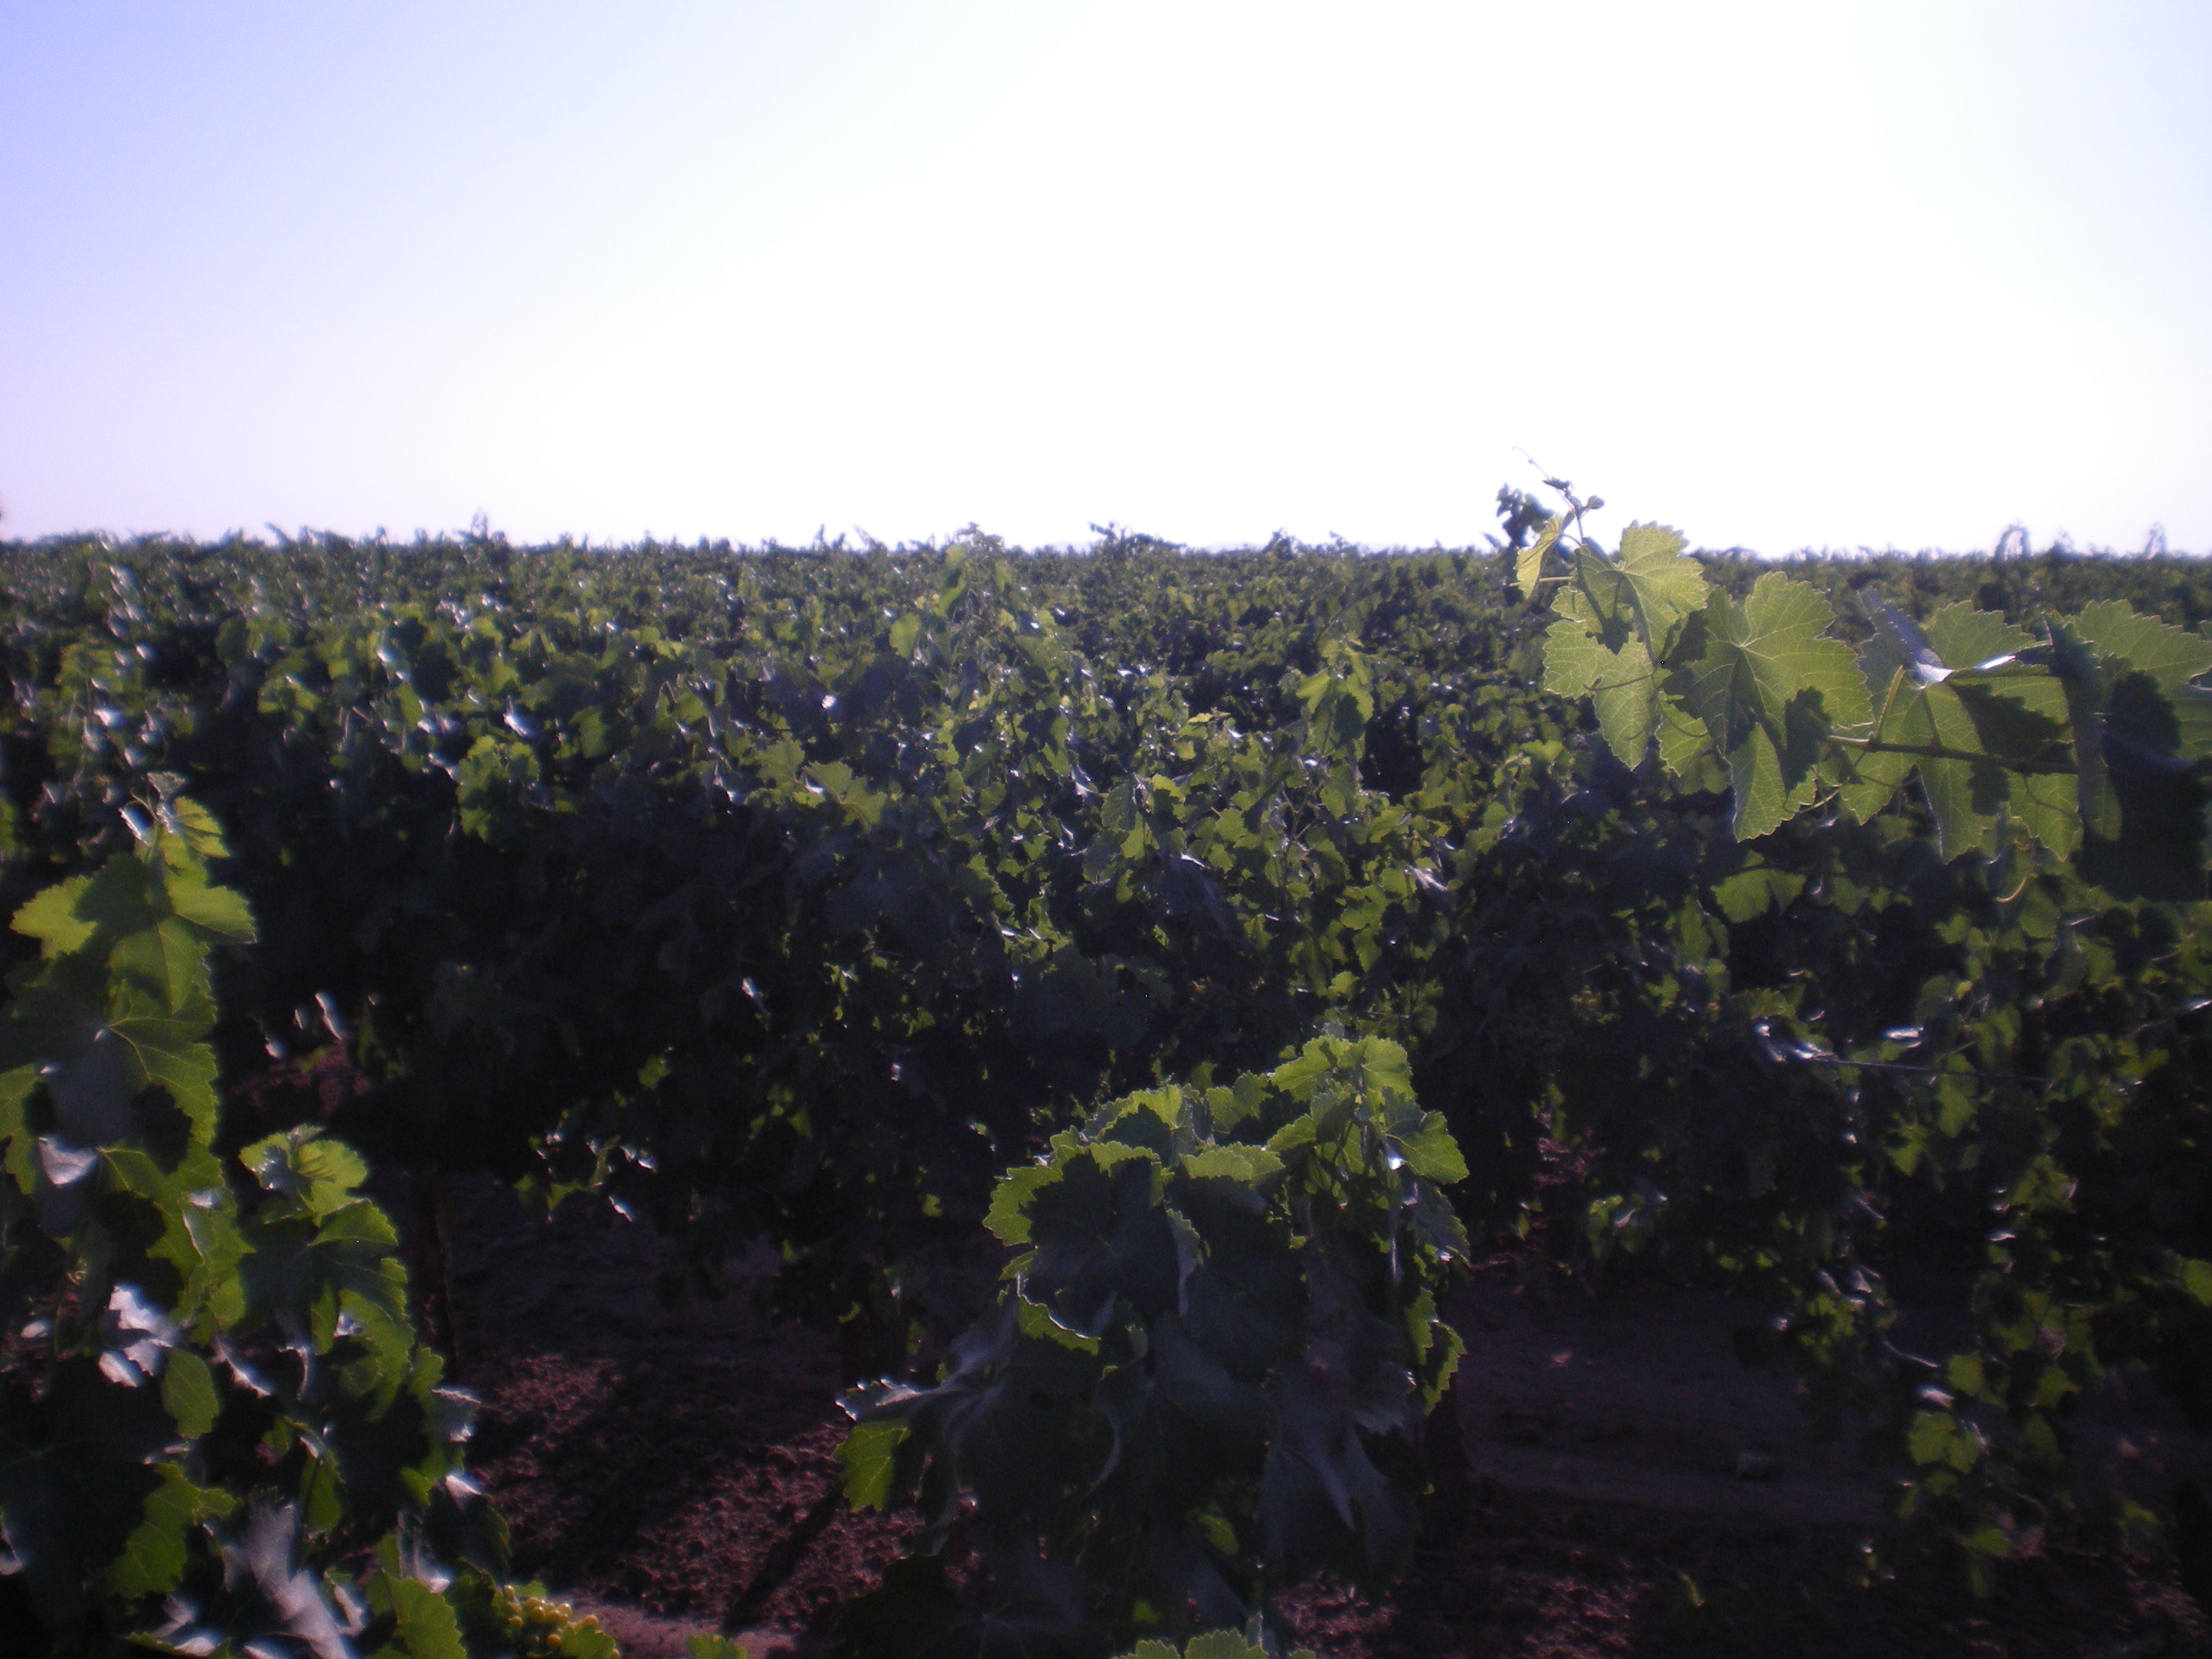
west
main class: Cropland
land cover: Vineyards
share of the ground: 25 - 50 %
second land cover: Other bare soil
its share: > 75 %
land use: Agriculture (excluding fallow land and kitchen gardens)
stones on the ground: < 10 %
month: July
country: ES
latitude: 39.3188
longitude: -3.1813
